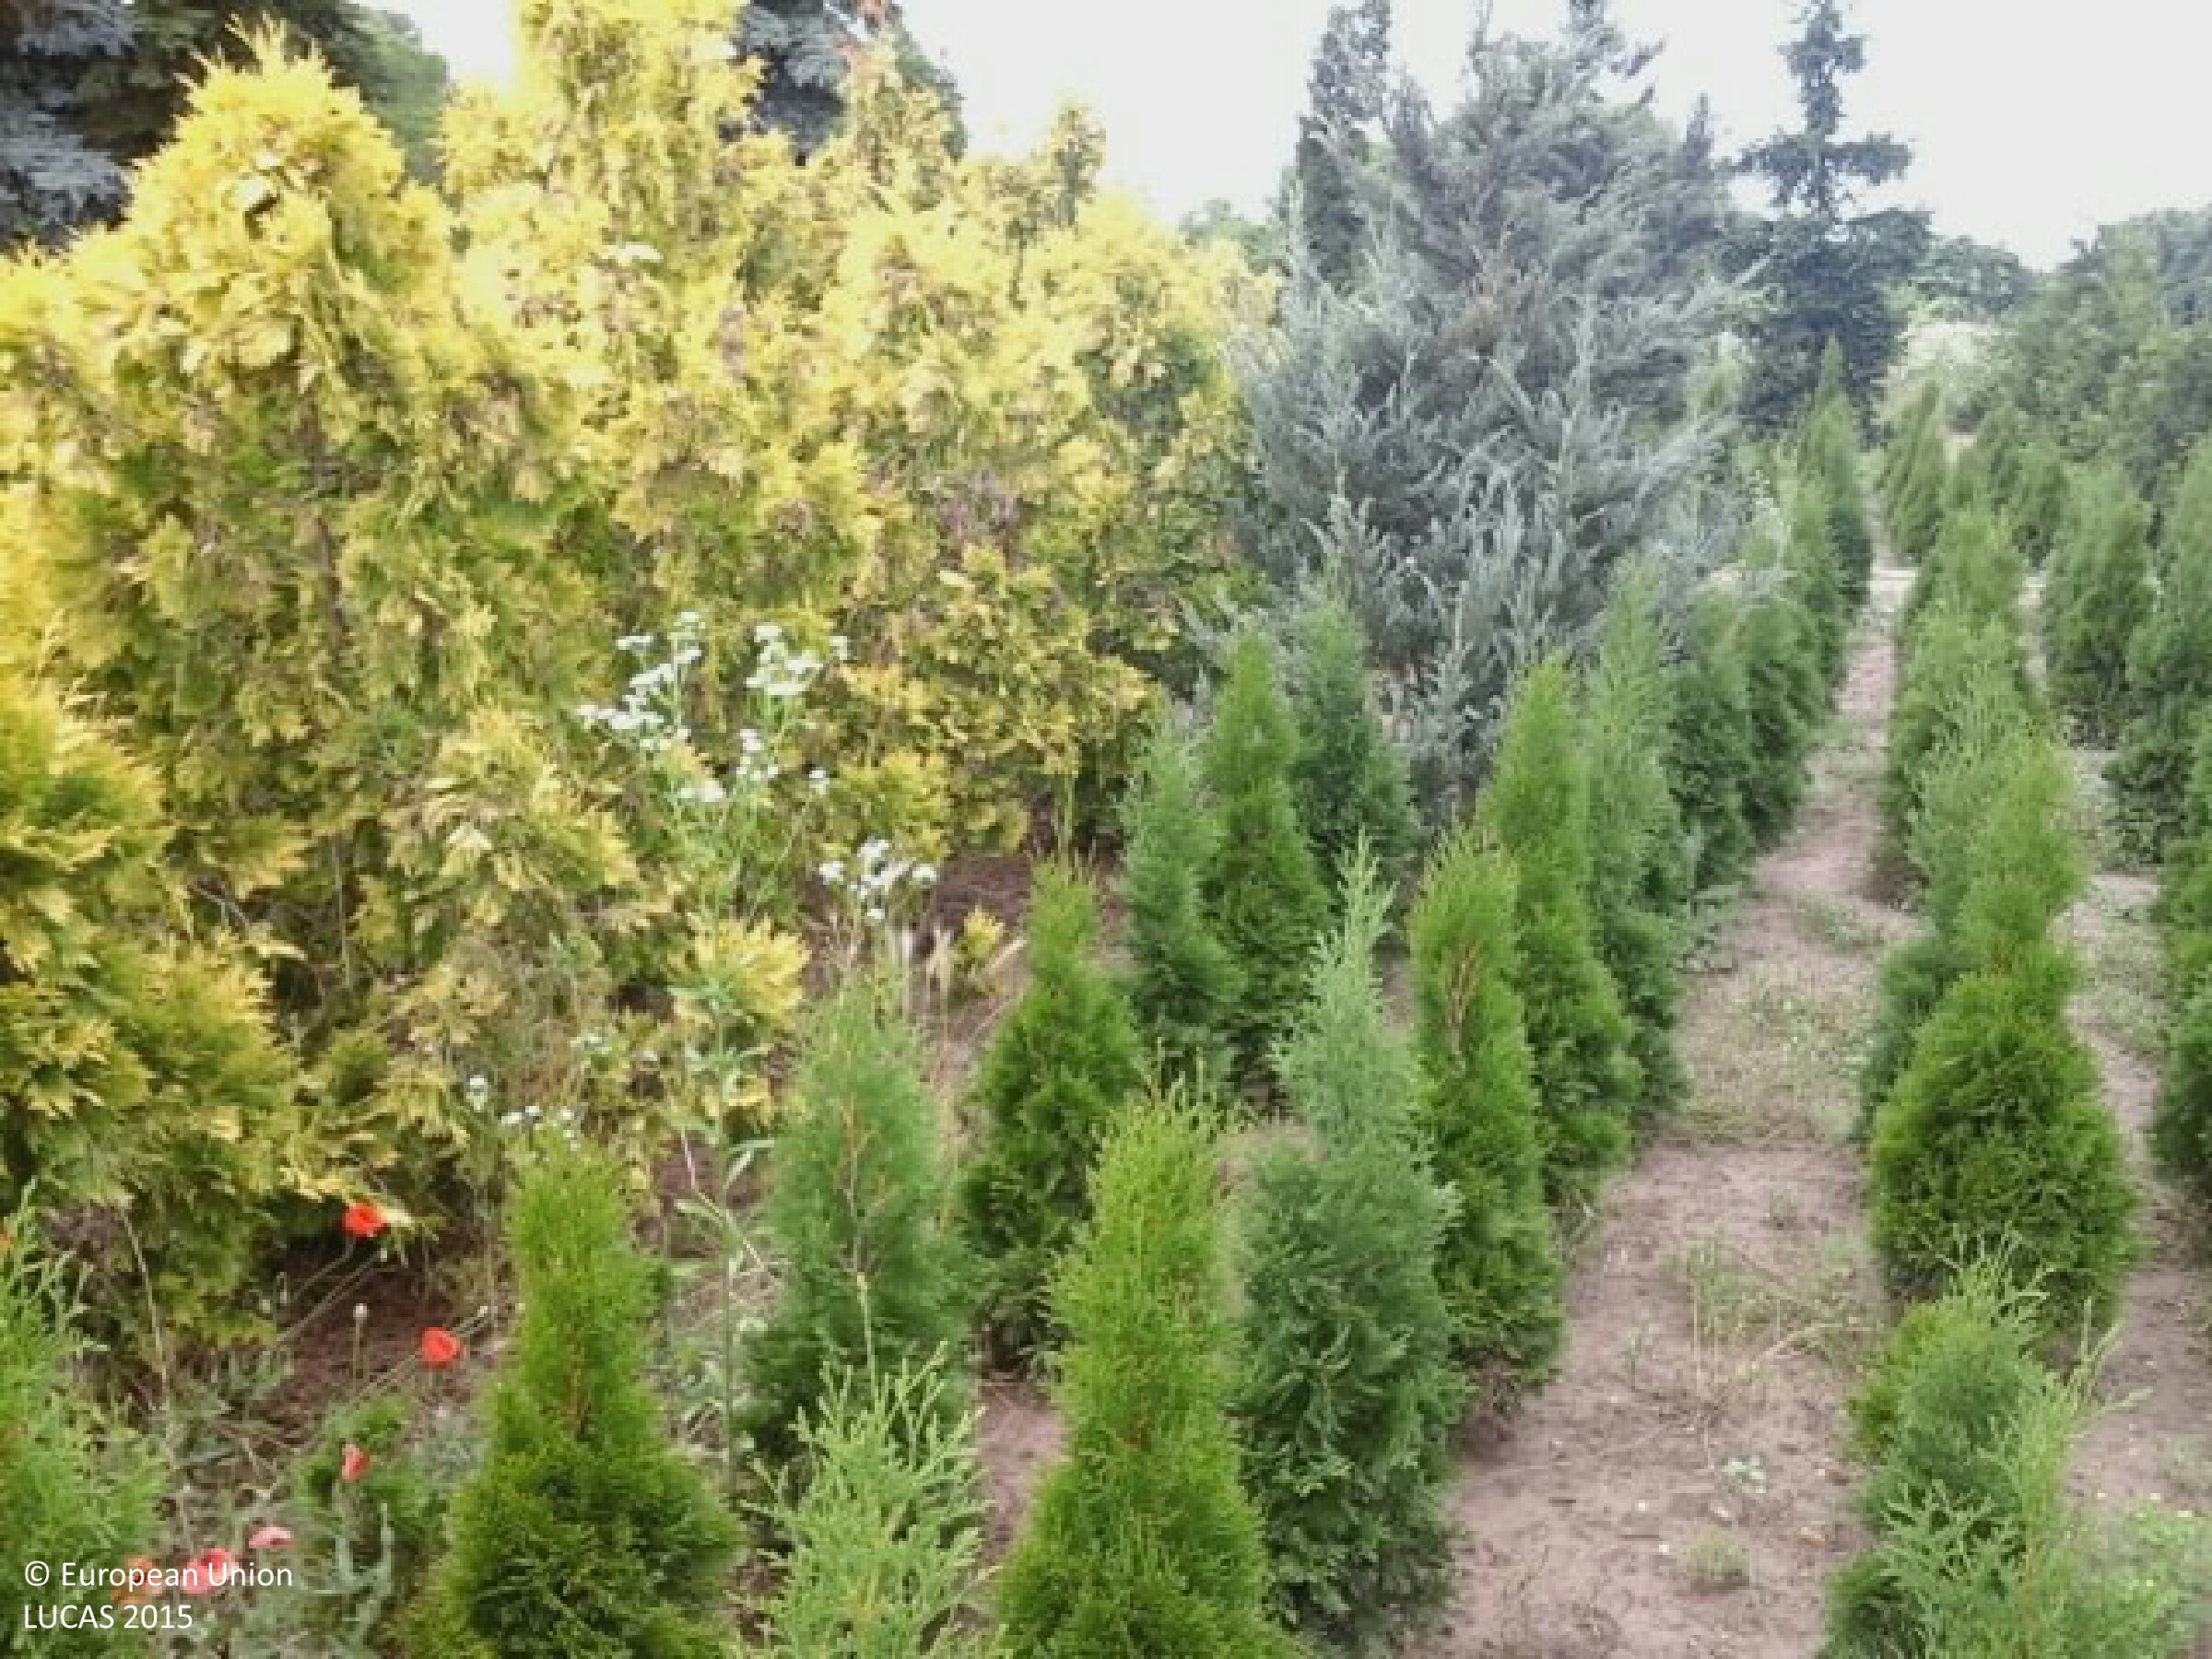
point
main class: Cropland
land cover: Nurseries
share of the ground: > 75 %
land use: Agriculture (excluding fallow land and kitchen gardens)
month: June
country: HU
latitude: 47.5282
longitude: 19.2239
